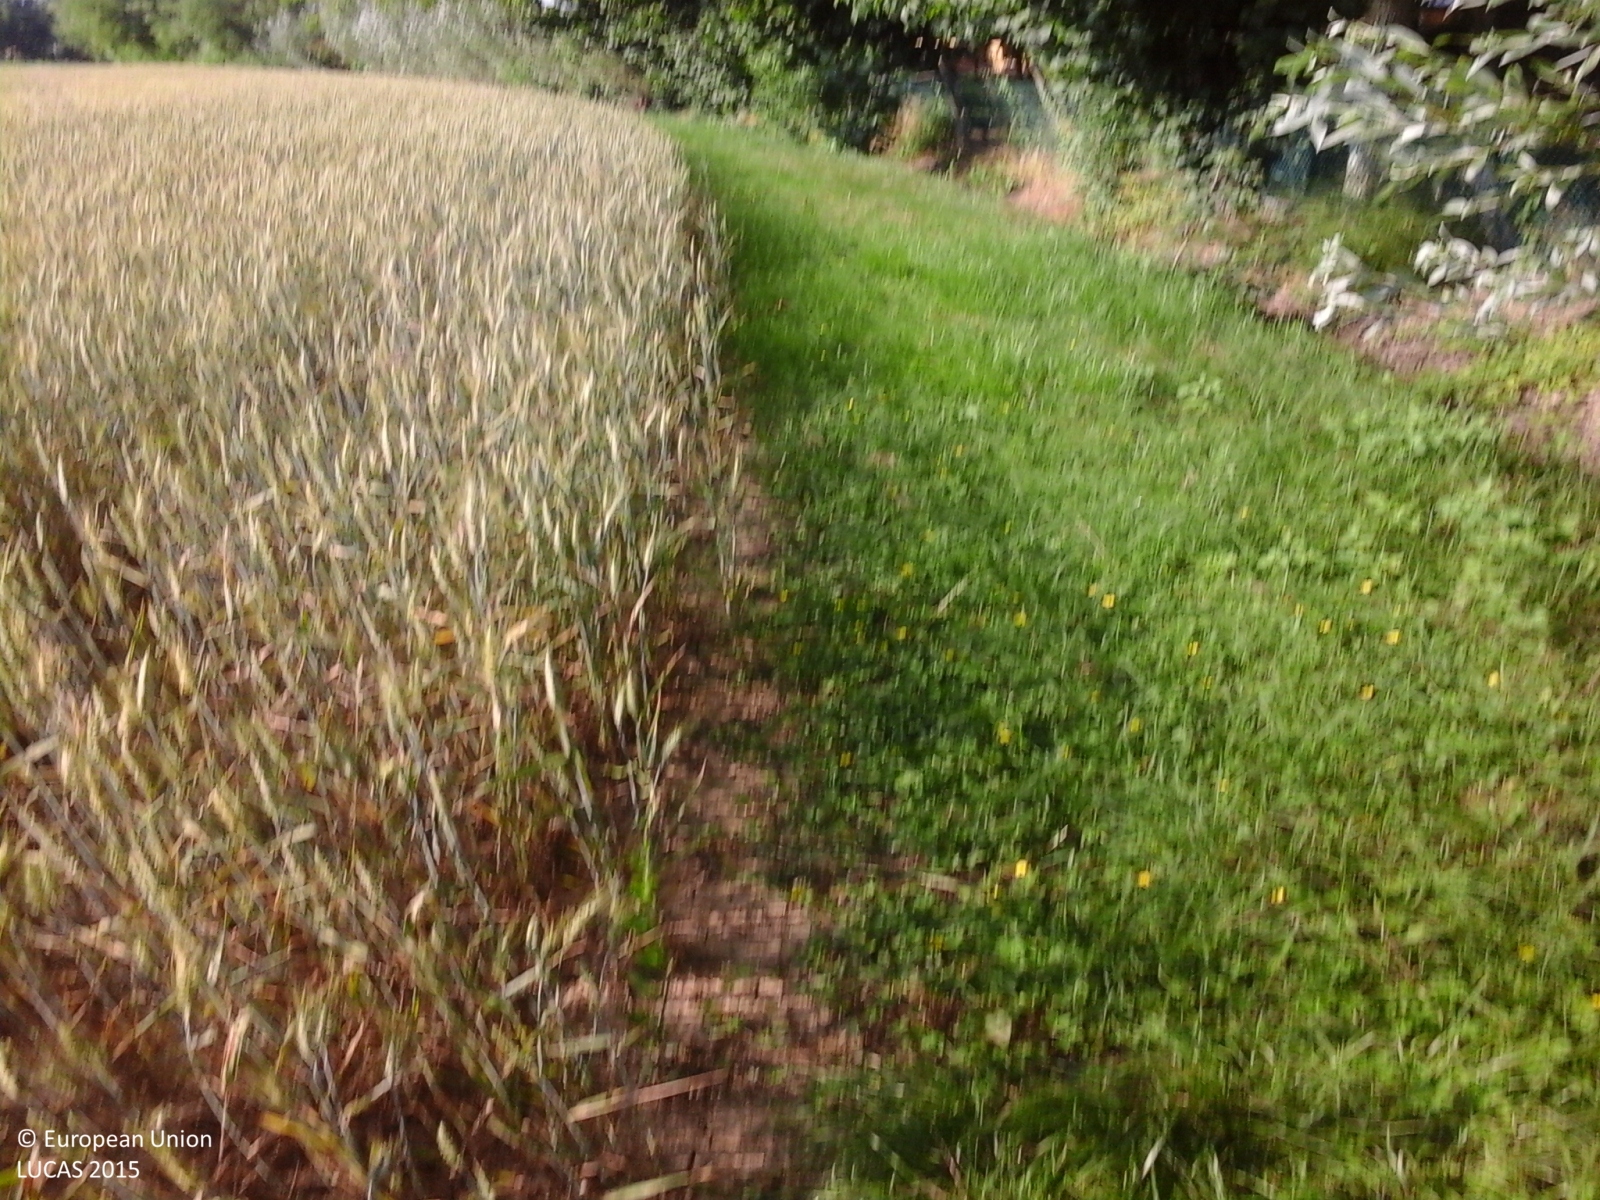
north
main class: Cropland
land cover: Common wheat
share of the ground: > 75 %
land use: Agriculture (excluding fallow land and kitchen gardens)
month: June
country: IT
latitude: 45.6052
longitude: 12.3172
